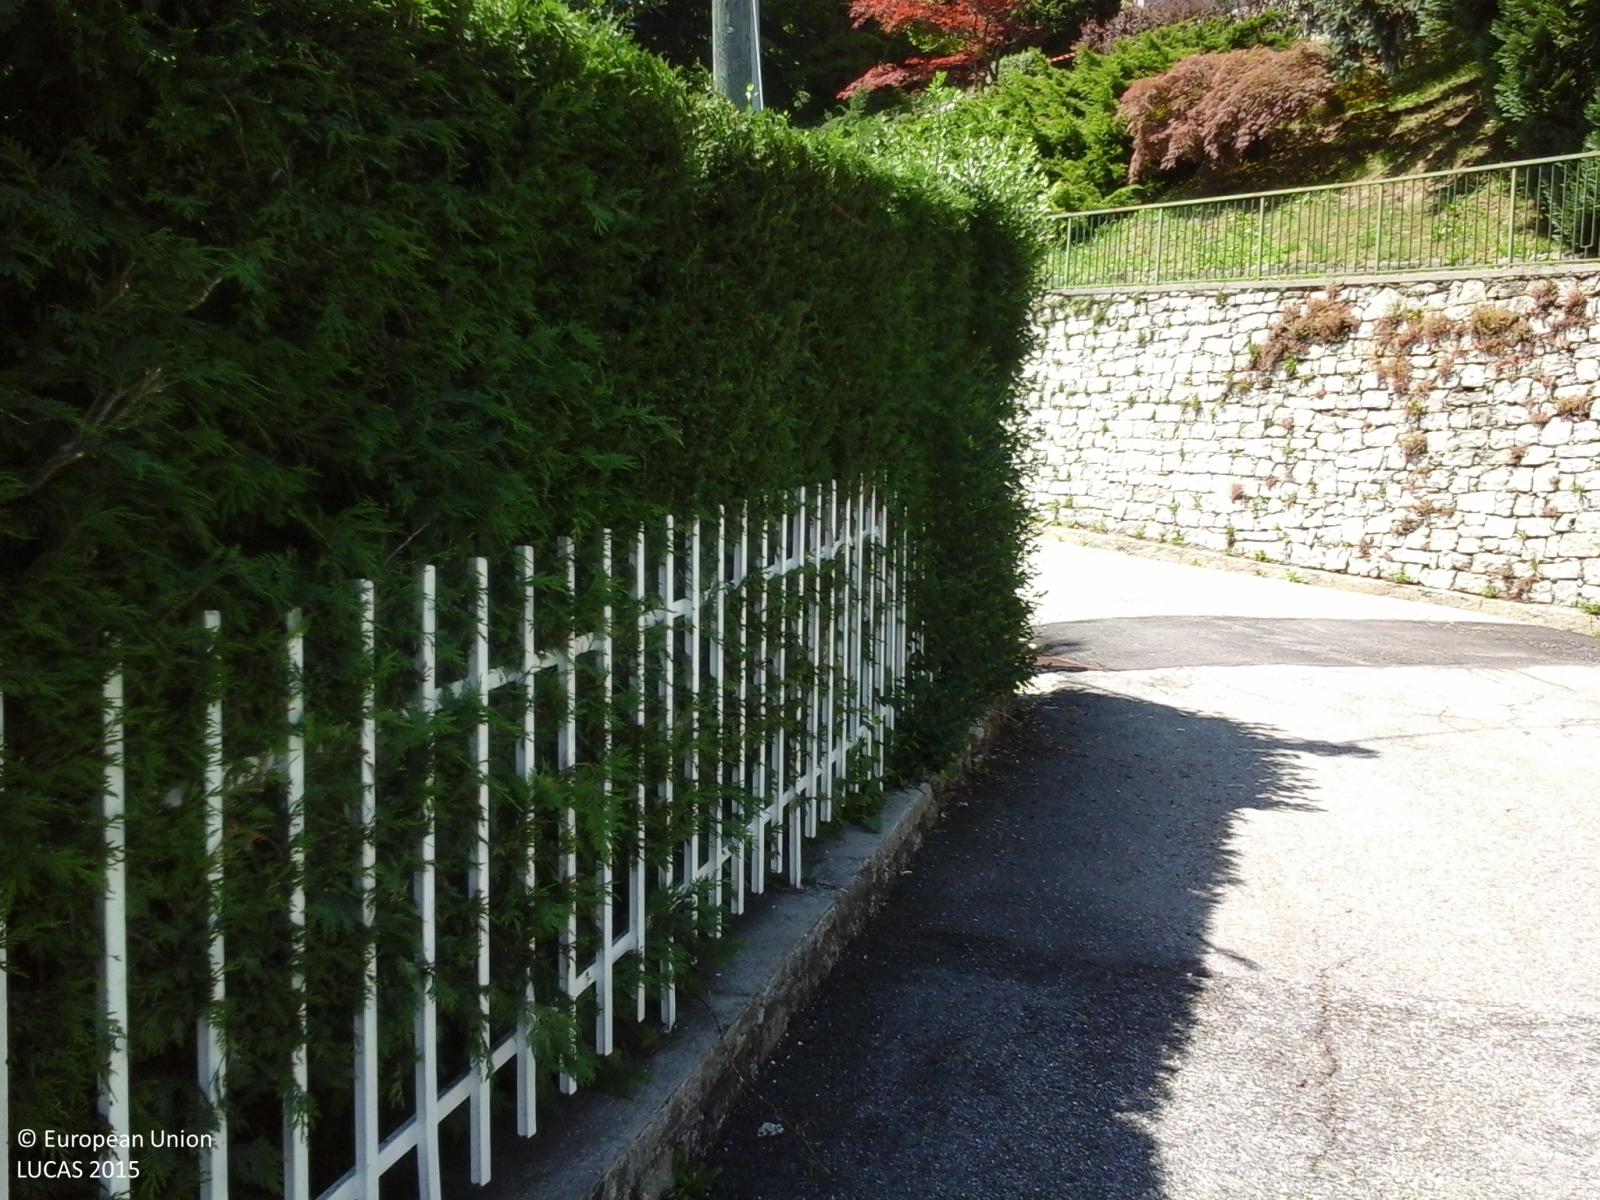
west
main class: Woodland
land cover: Broadleaved woodland
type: thermophilous deciduous forest
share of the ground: > 75 %
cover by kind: broadleaved forest trees 100 %
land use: Forestry
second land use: Amenities, museums, leisure
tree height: > 5 m
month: June
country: IT
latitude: 45.9816
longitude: 8.5950
